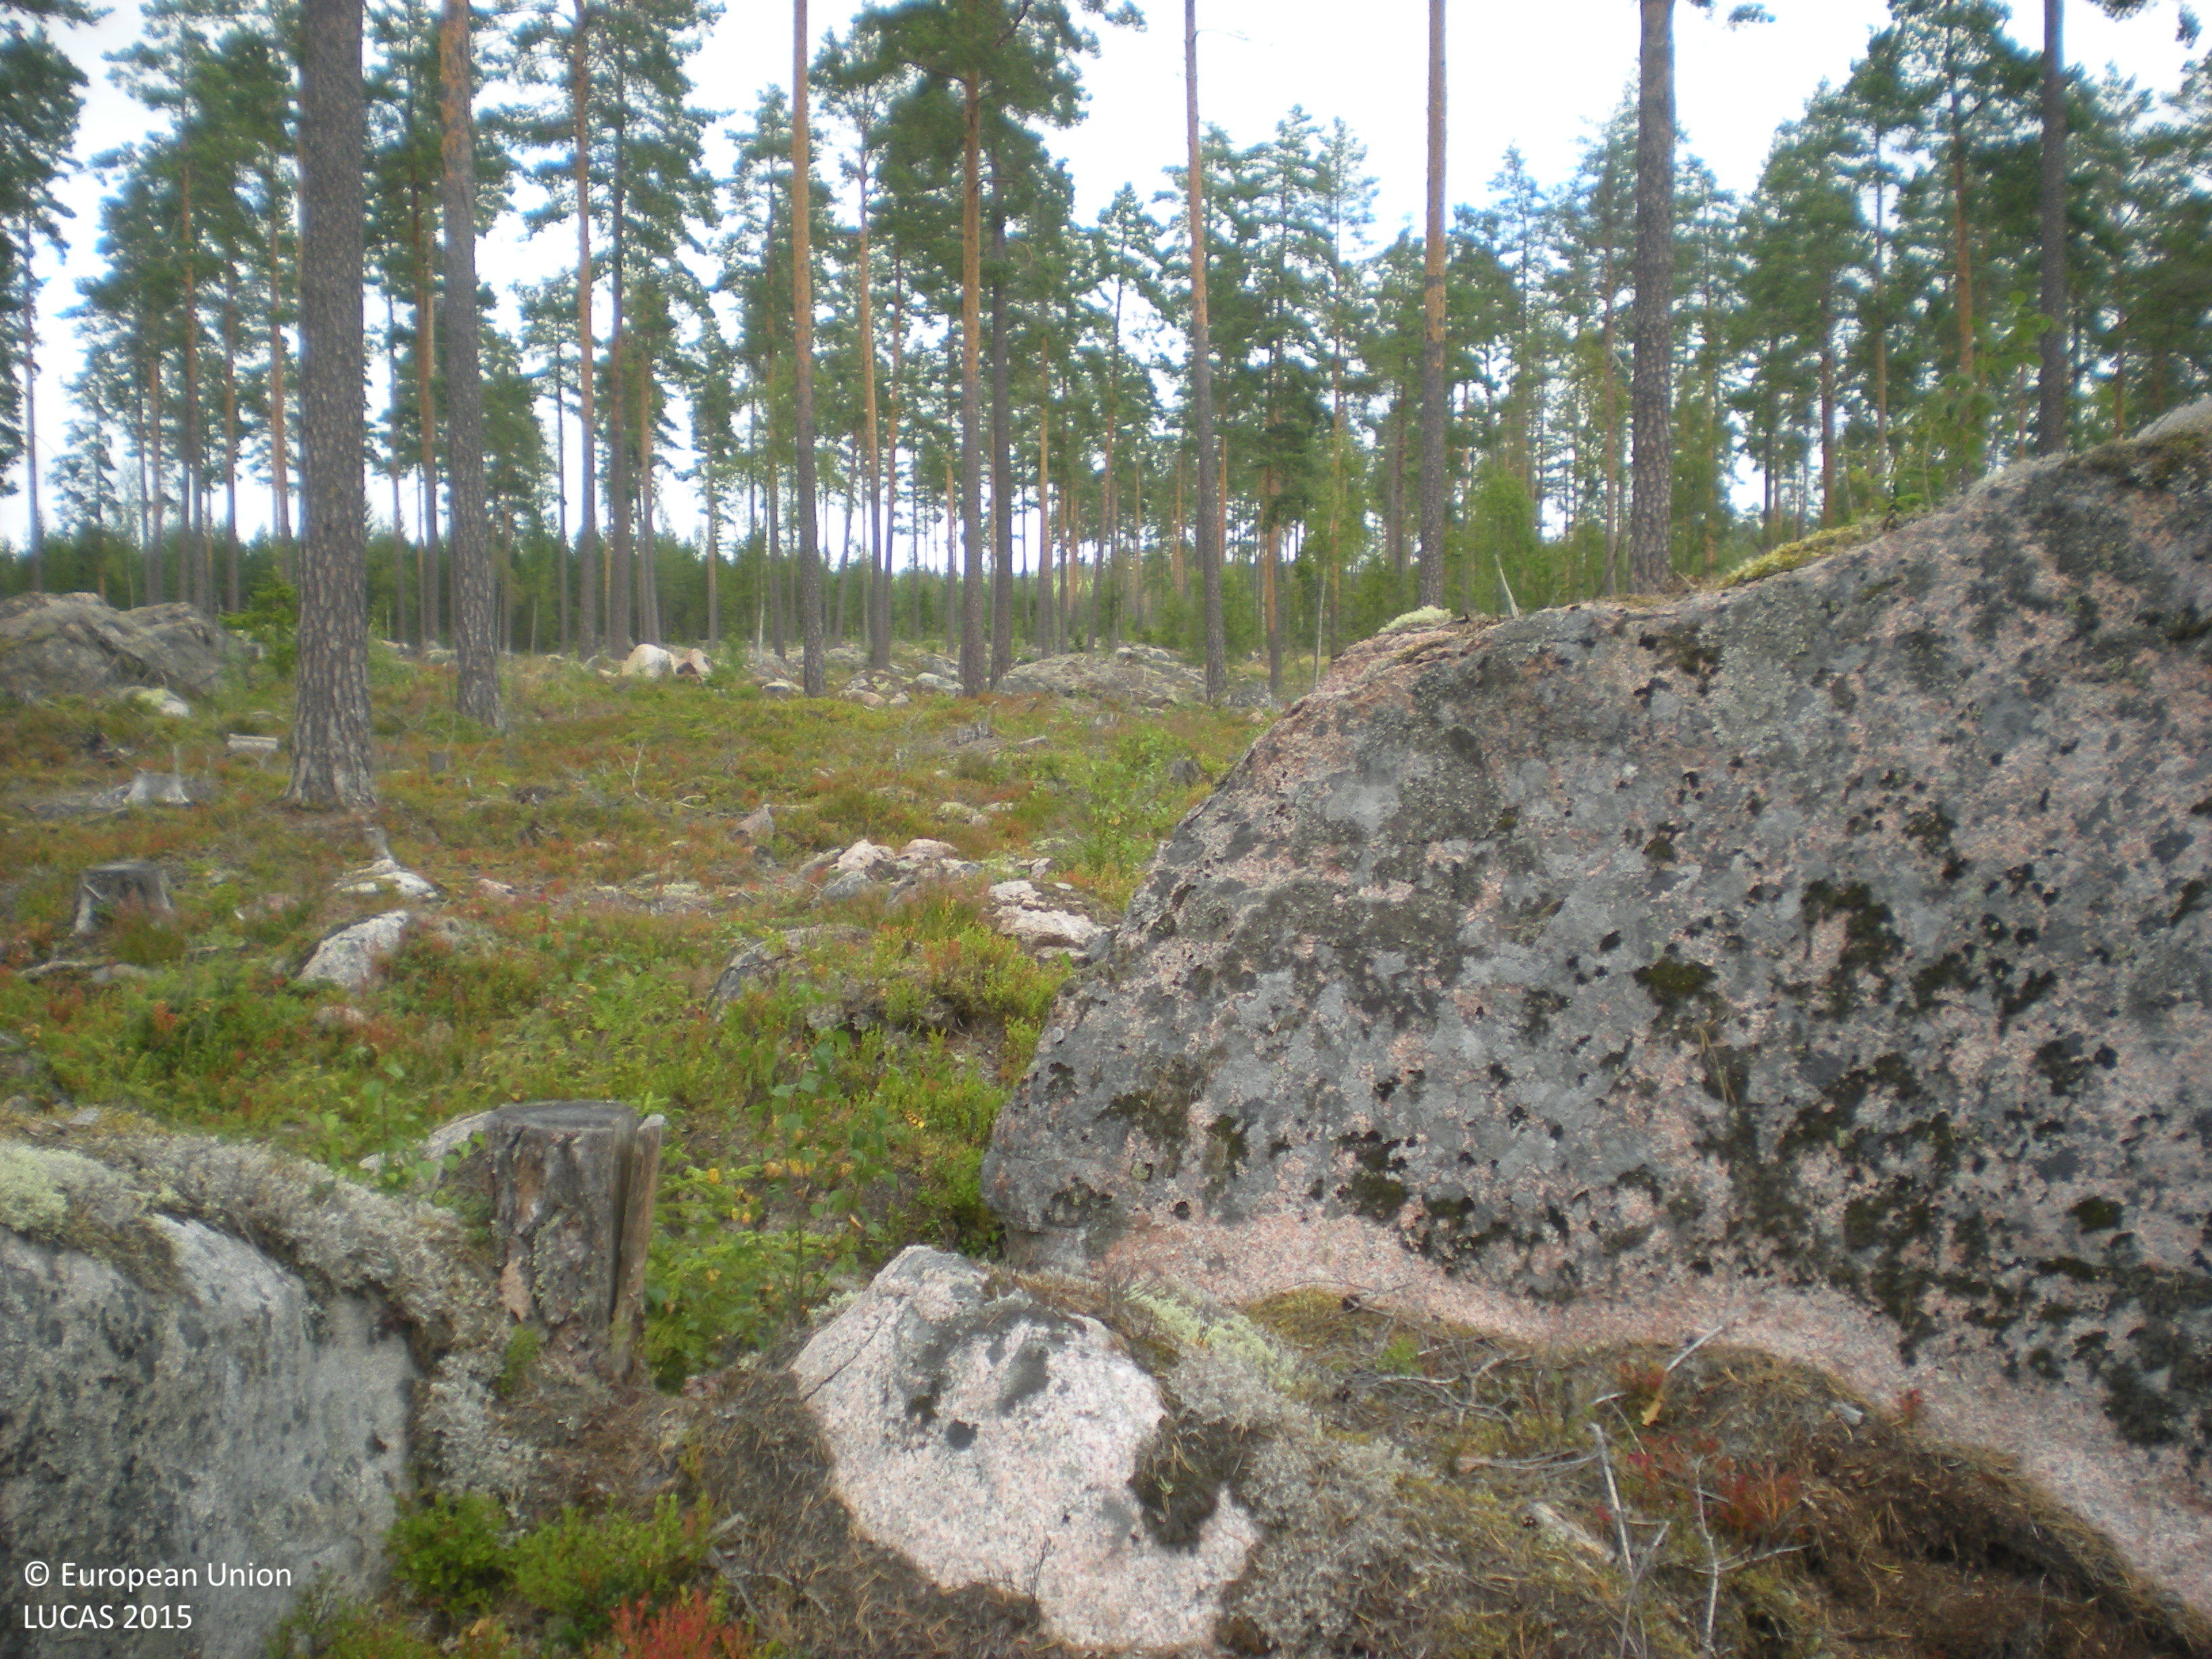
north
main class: Woodland
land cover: Pine dominated coniferous woodland
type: boreal forest
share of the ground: 25 - 50 %
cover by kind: coniferous forest trees 40 %, shrubs 25 %, consolidated bare surface 20 %, lichens and mosses 10 %, broadleaved forest trees 5 %
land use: Forestry
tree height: > 5 m
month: August
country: SE
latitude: 60.4323
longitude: 16.8022
